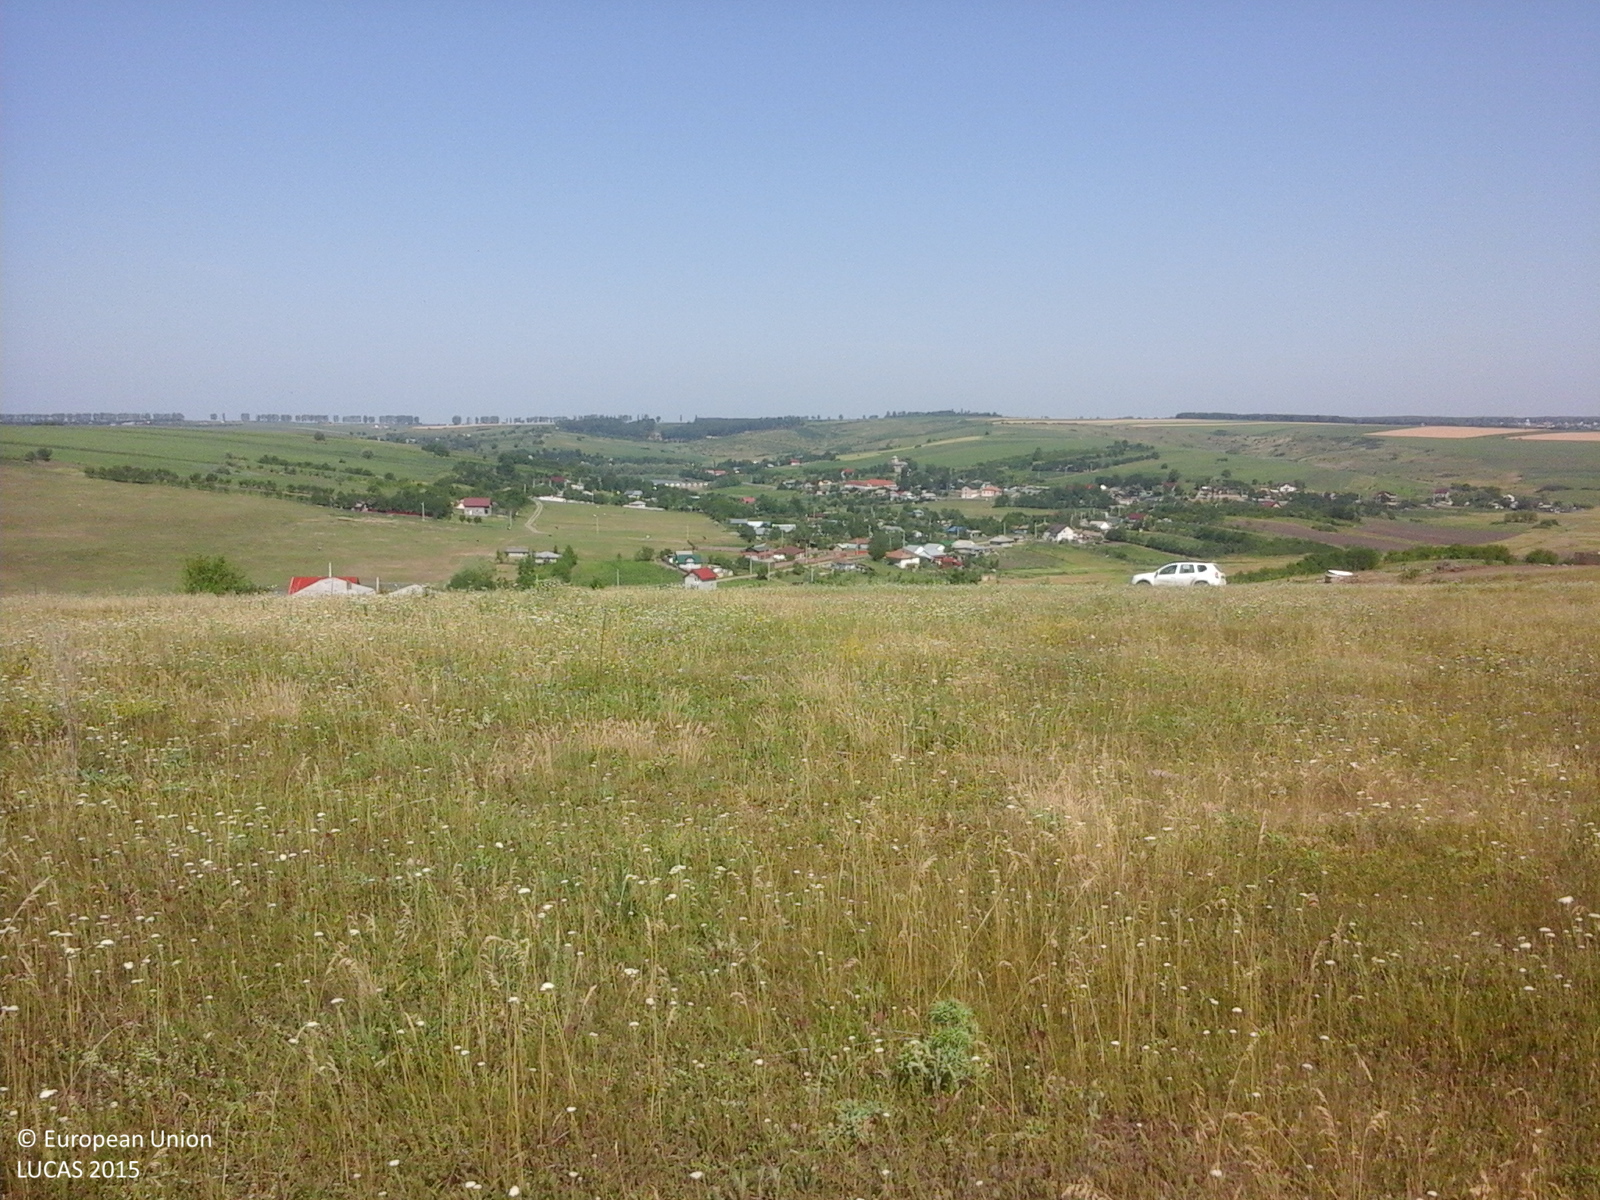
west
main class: Grassland
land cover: Grassland without tree/shrub cover
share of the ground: > 75 %
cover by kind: herbaceous plants 100 %
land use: Agriculture (excluding fallow land and kitchen gardens)
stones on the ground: < 10 %
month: June
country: RO
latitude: 47.1000
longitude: 27.5211
